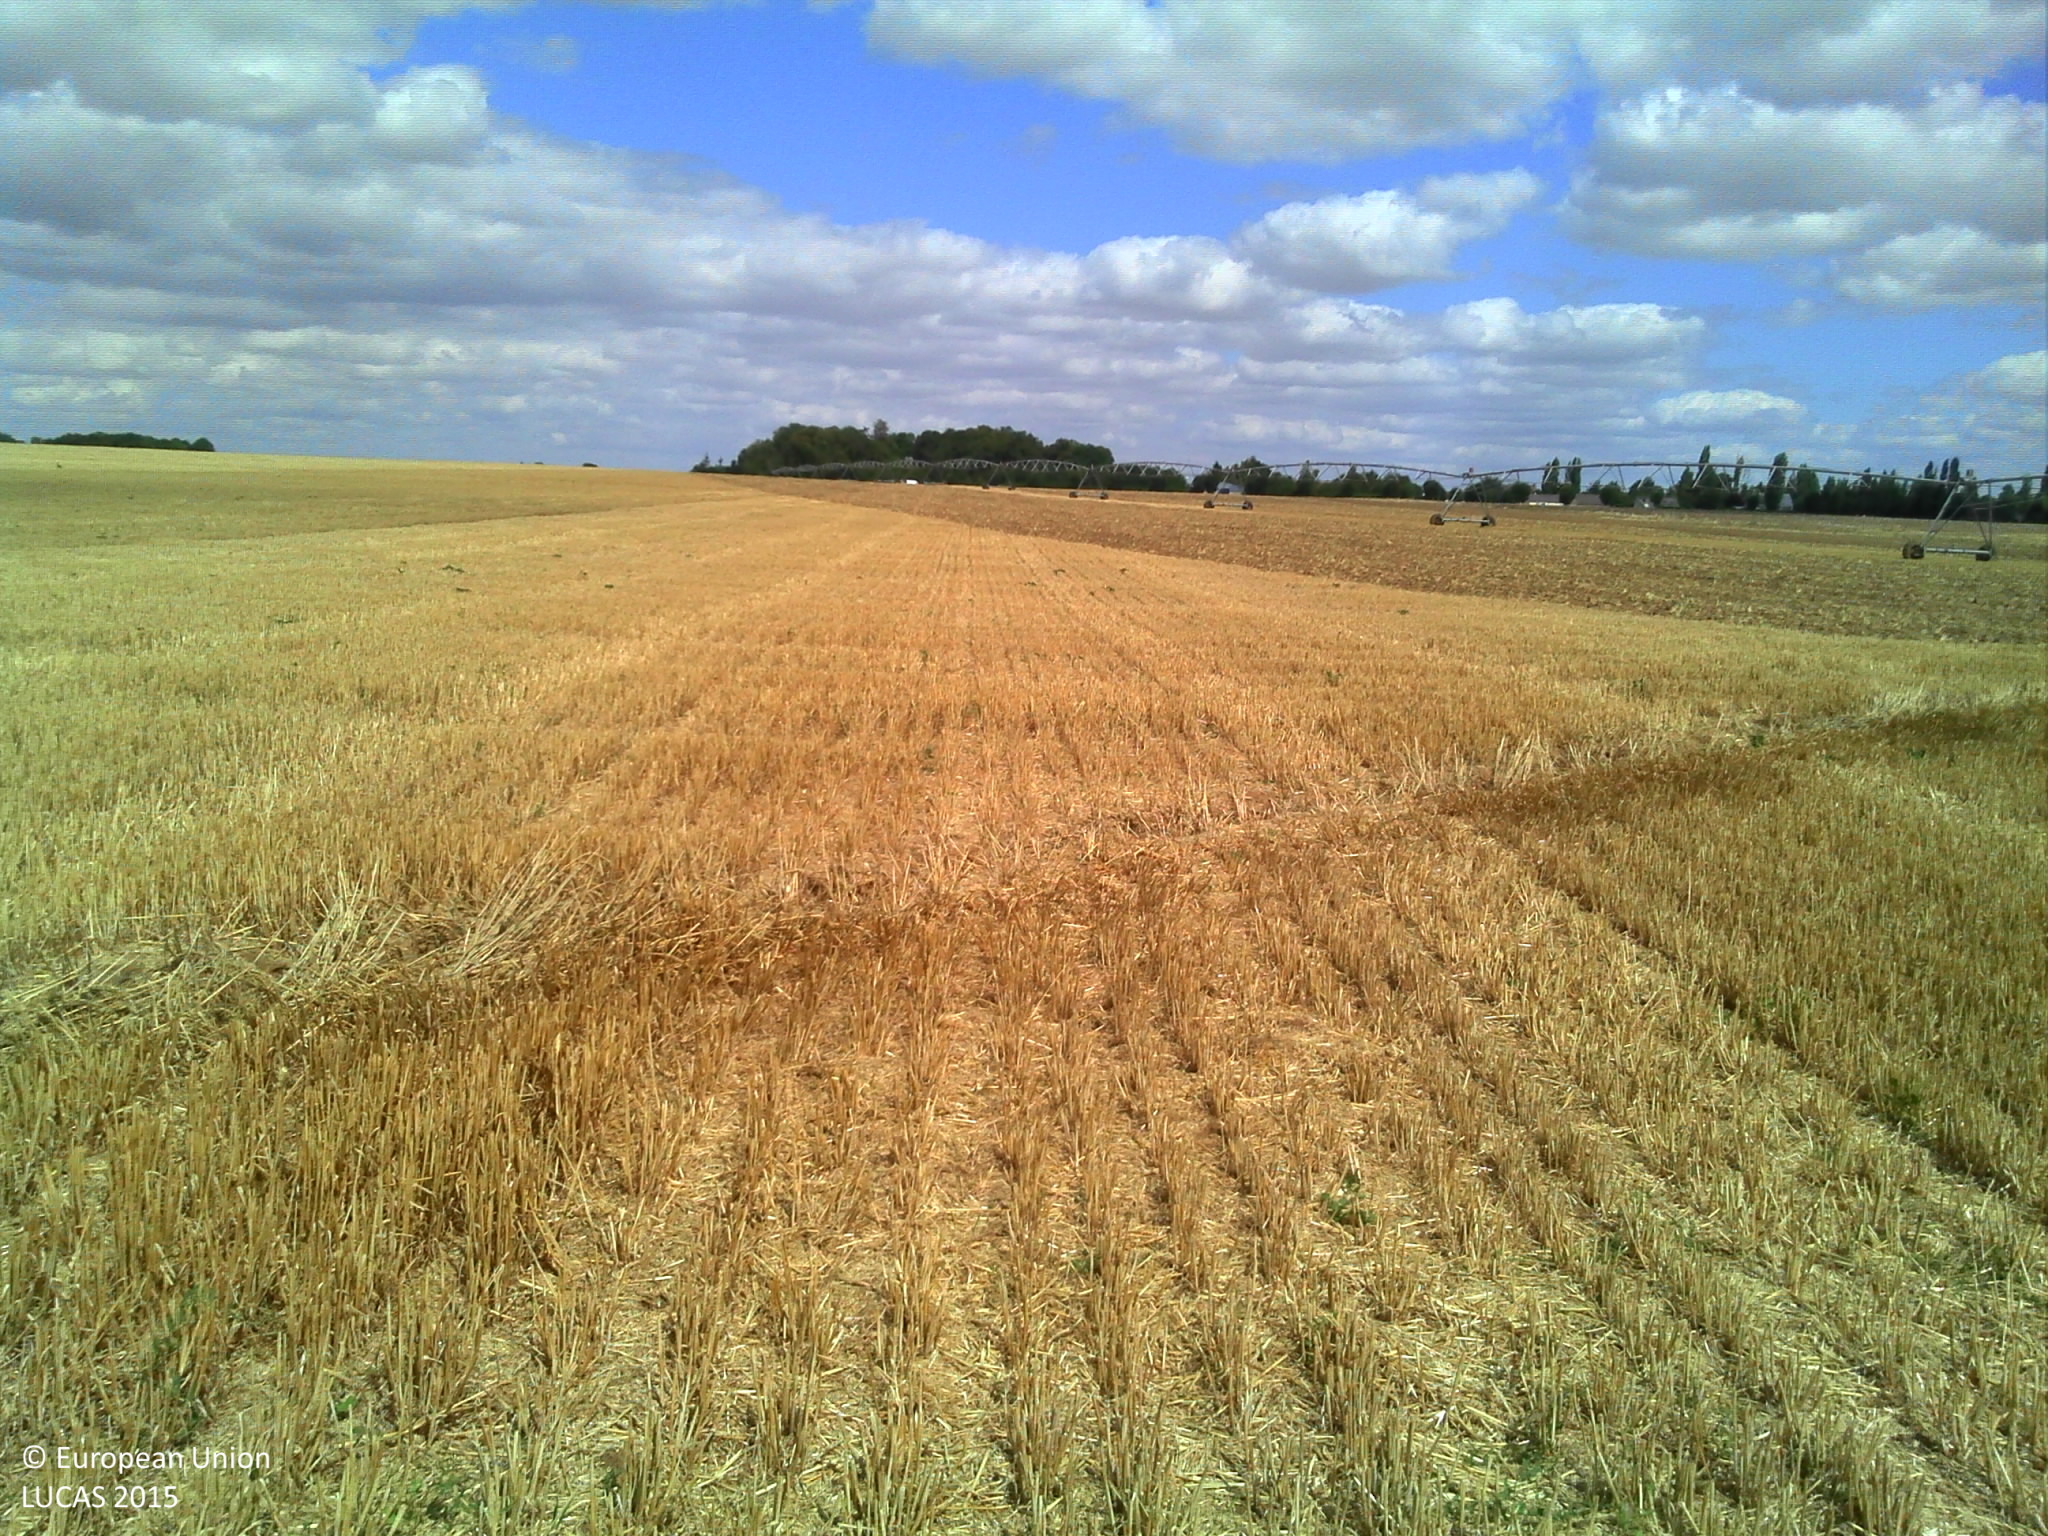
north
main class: Cropland
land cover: Common wheat
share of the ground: > 75 %
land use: Agriculture (excluding fallow land and kitchen gardens)
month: August
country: FR
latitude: 48.2043
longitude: 2.0080
